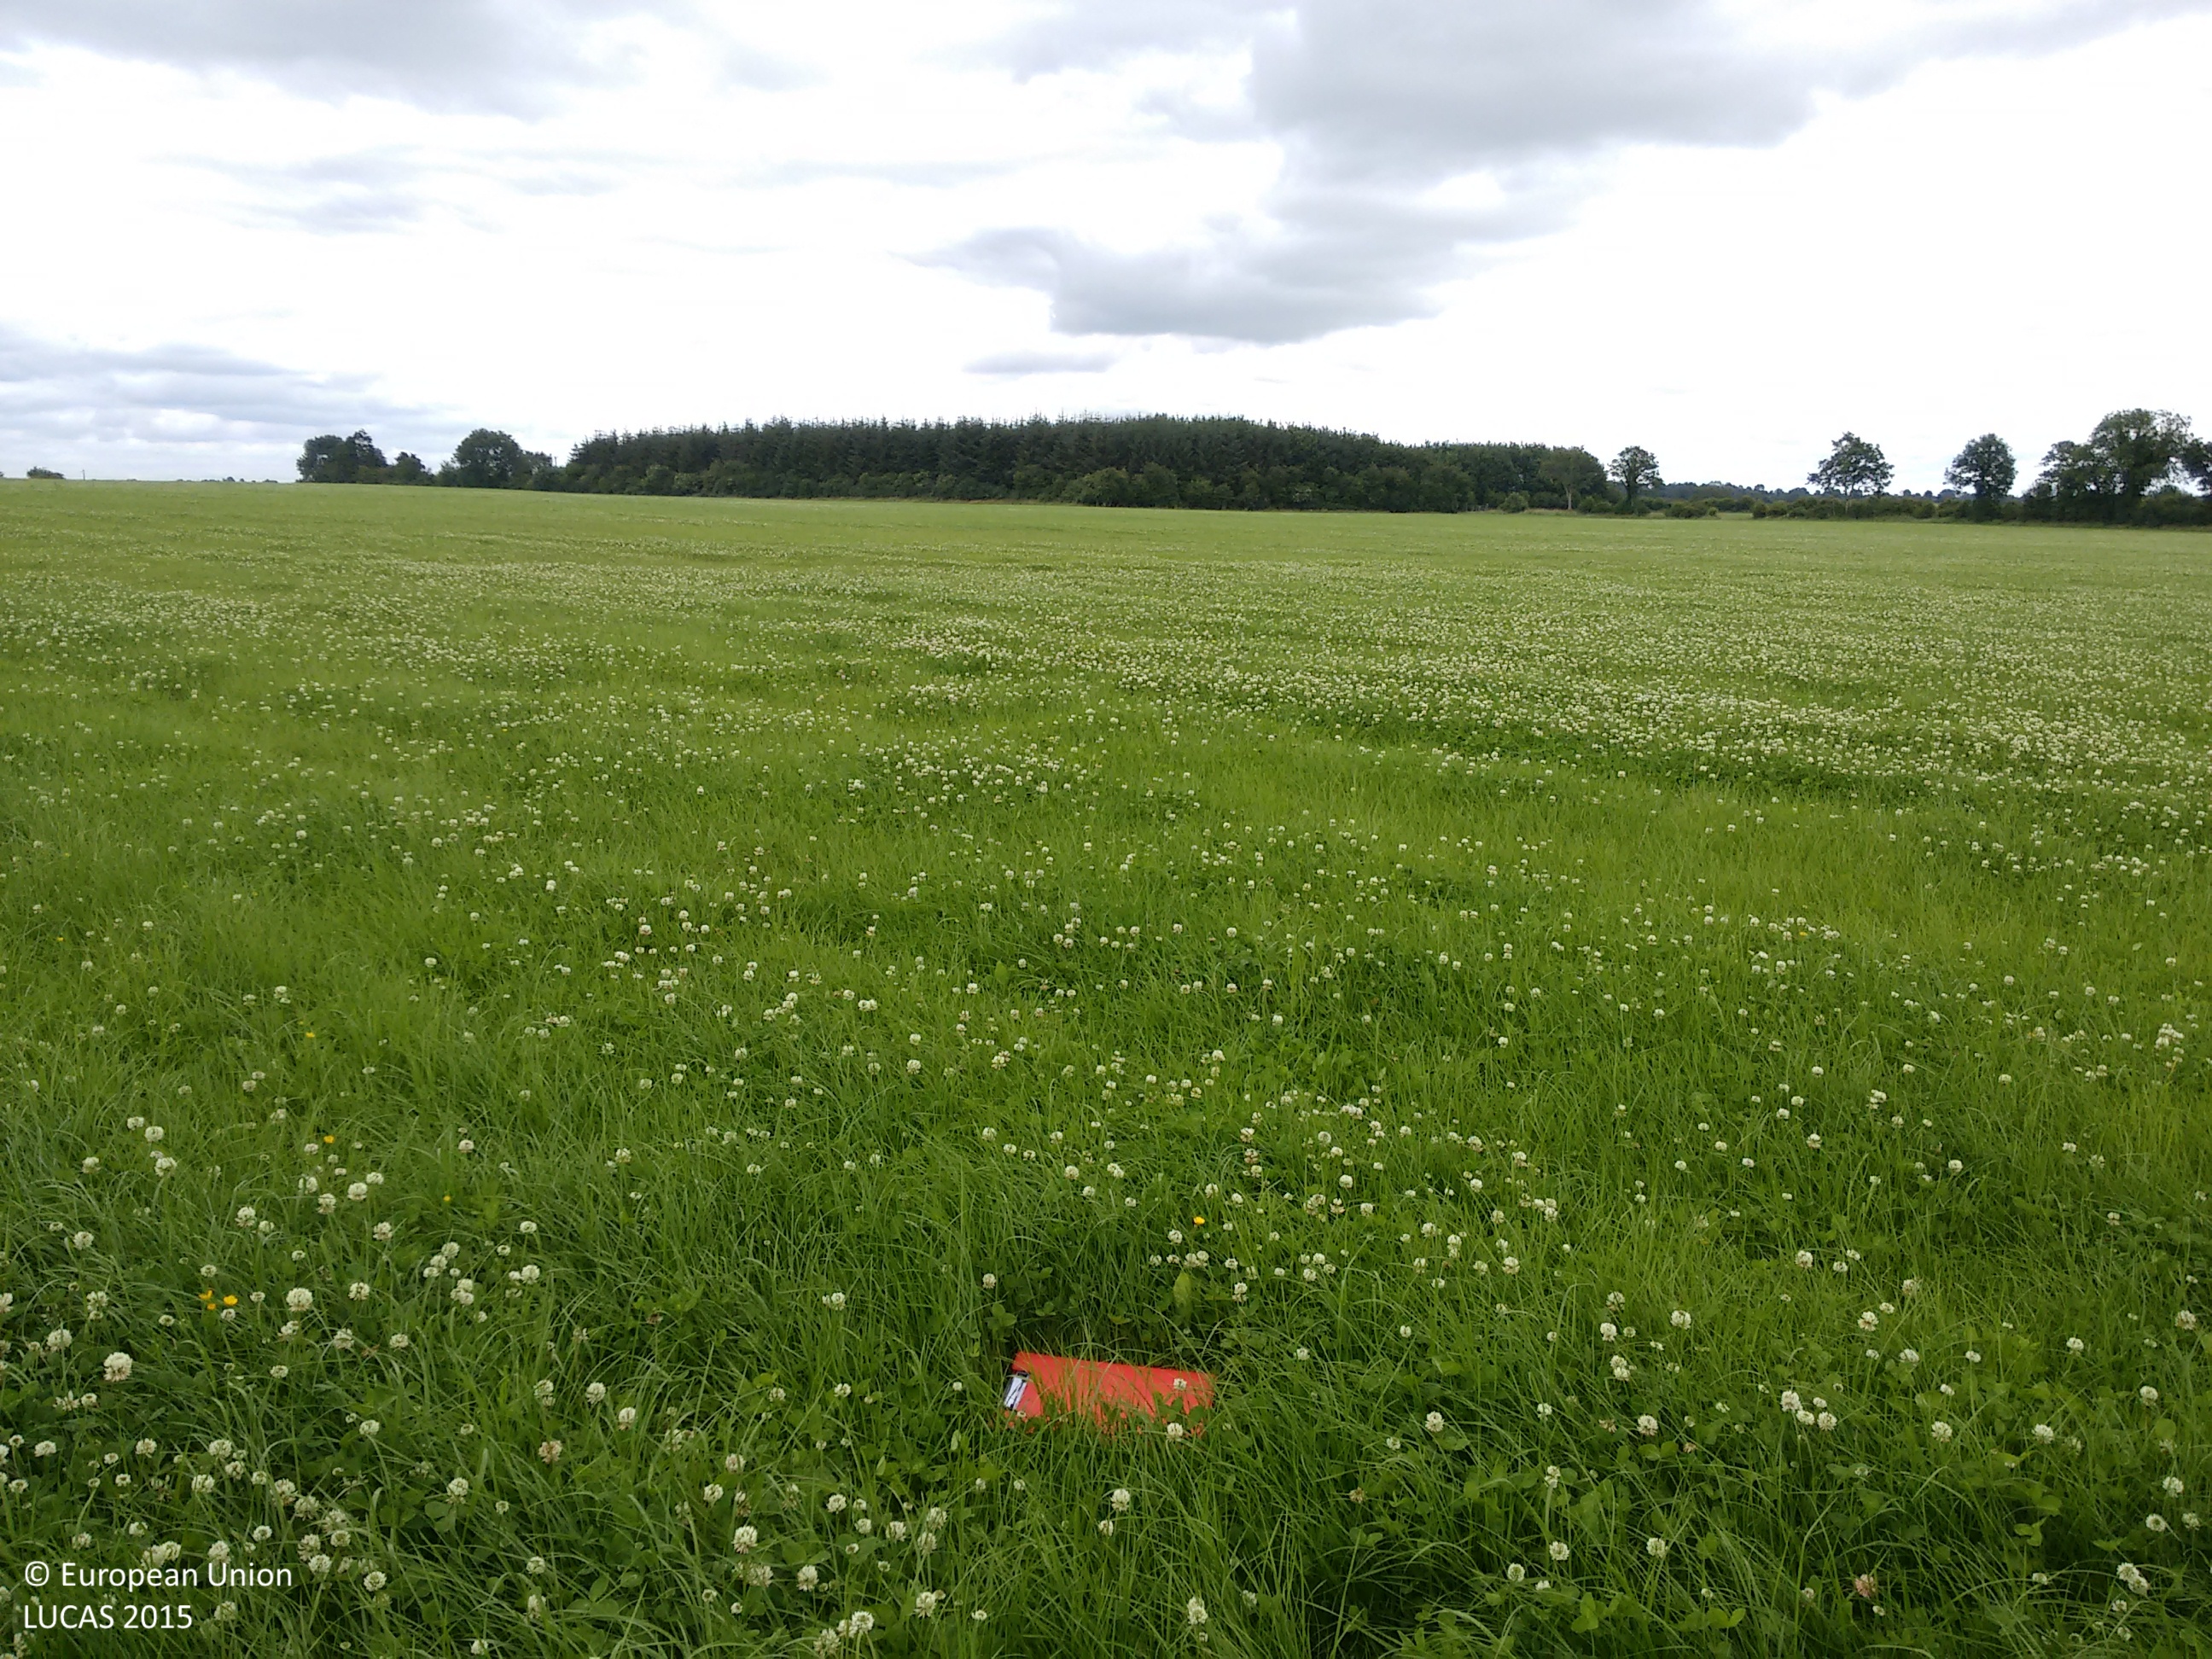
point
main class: Cropland
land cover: Temporary grasslands
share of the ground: > 75 %
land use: Agriculture (excluding fallow land and kitchen gardens)
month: July
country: IE
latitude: 53.4981
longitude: -7.7278
